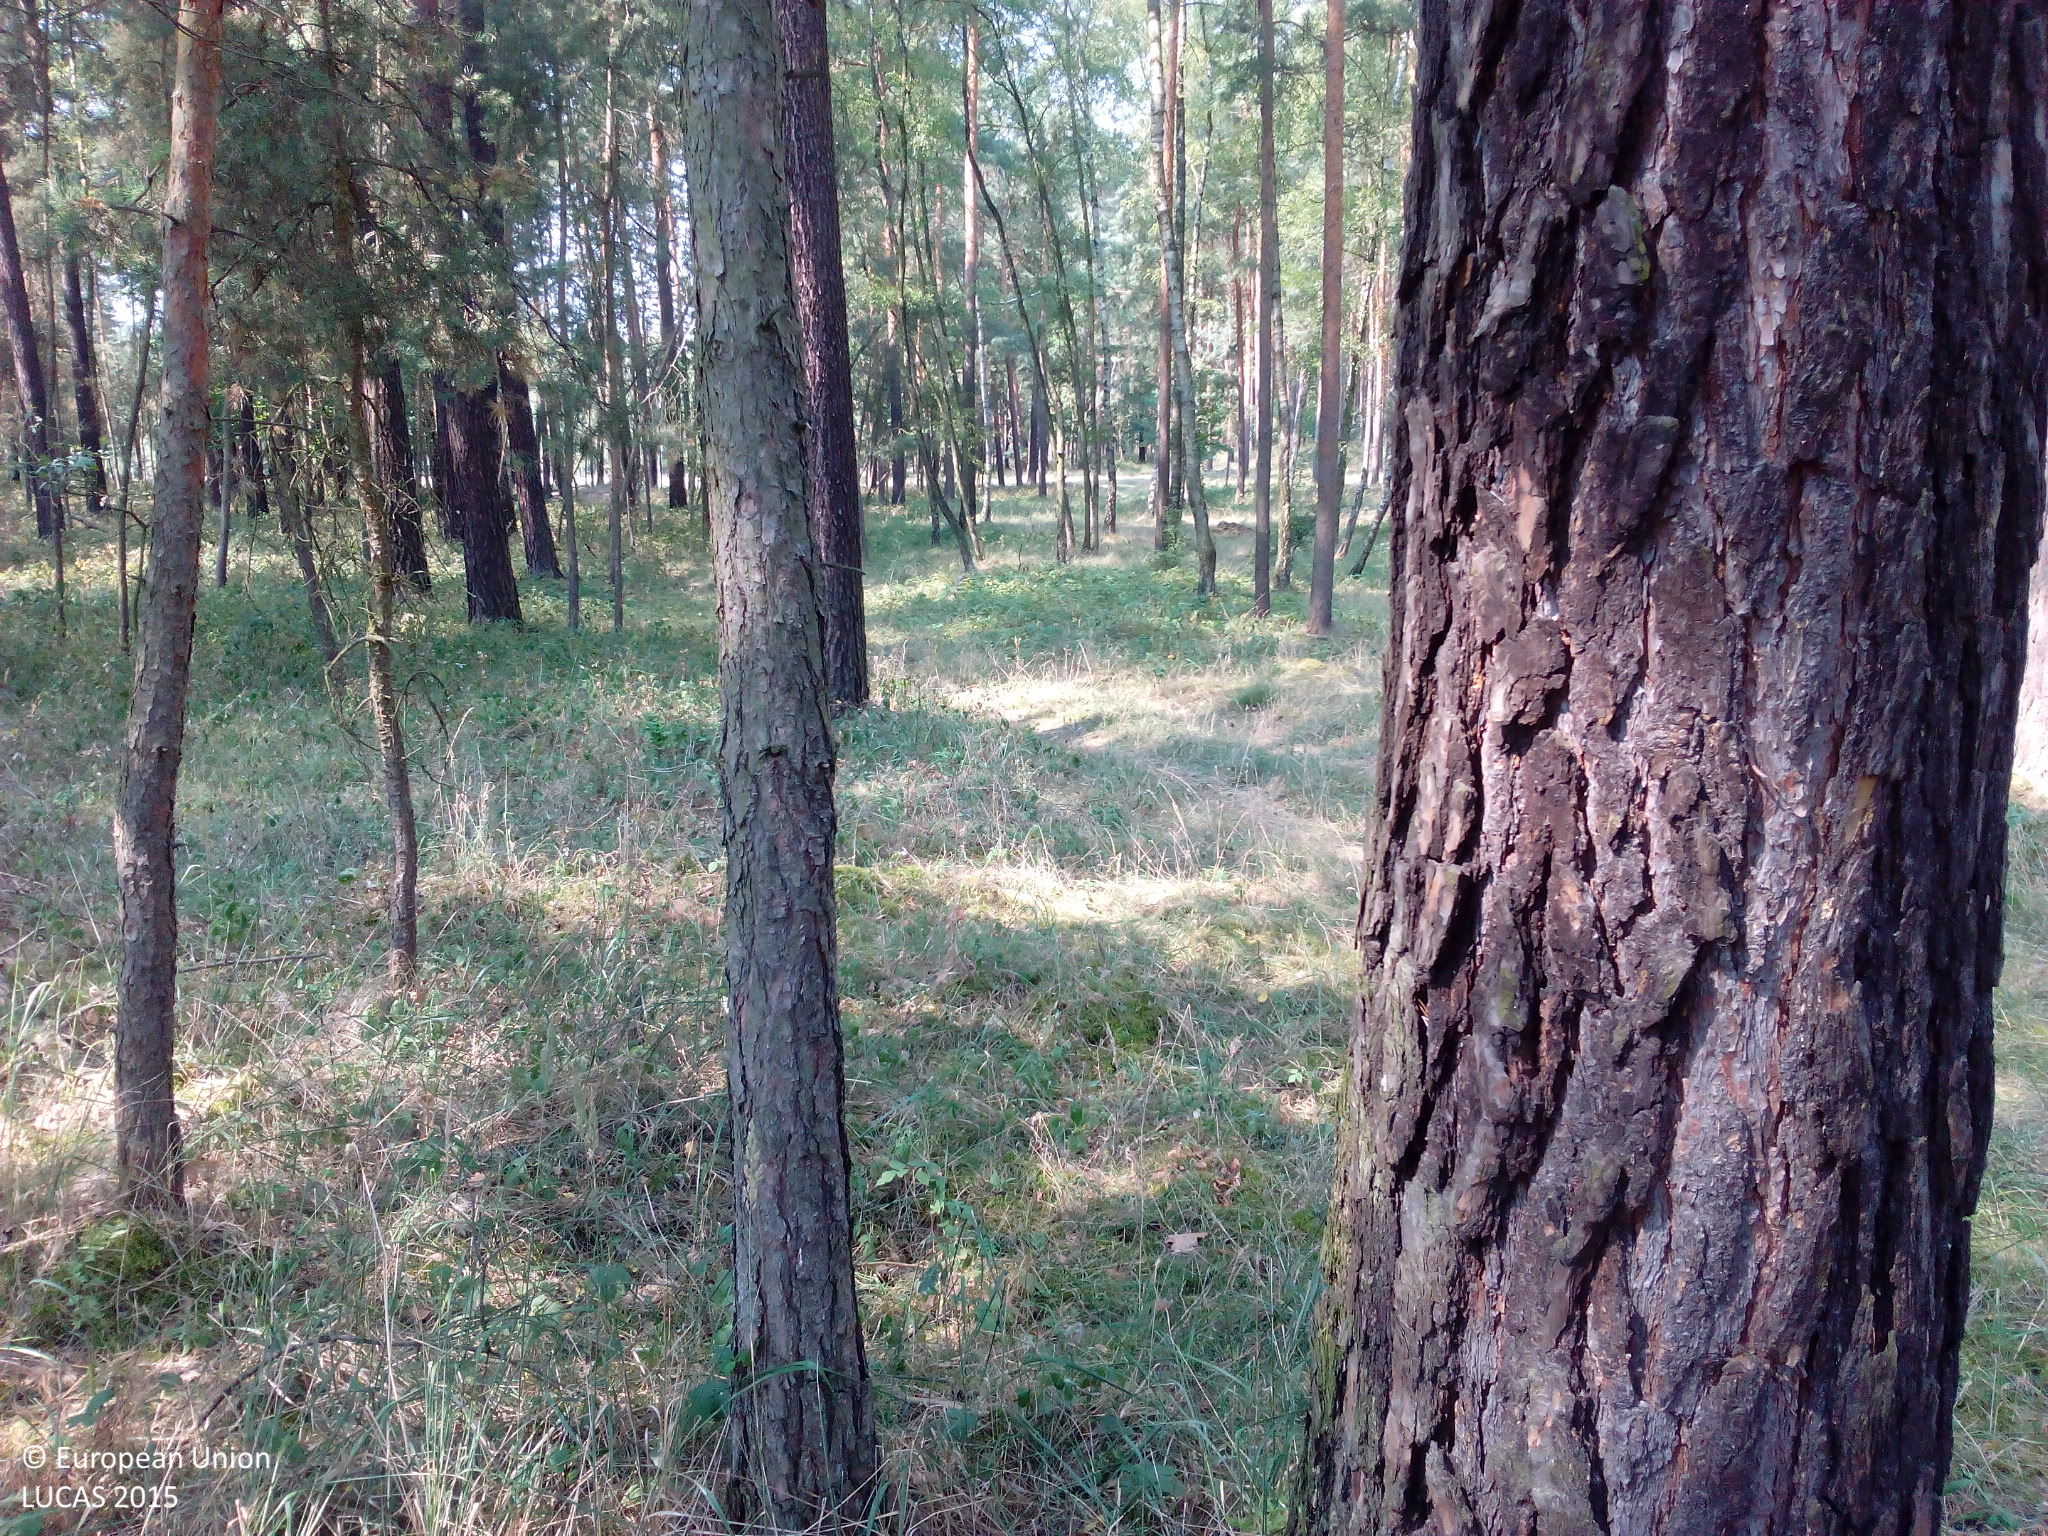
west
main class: Woodland
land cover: Pine dominated coniferous woodland
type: hemiboreal forest and nemoral coniferous forest and mixed broadleaved-coniferous forest
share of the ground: > 75 %
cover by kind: coniferous forest trees 95 %, herbaceous plants 5 %
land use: Forestry
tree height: > 5 m
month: August
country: DE
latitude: 51.7563
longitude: 12.5640
